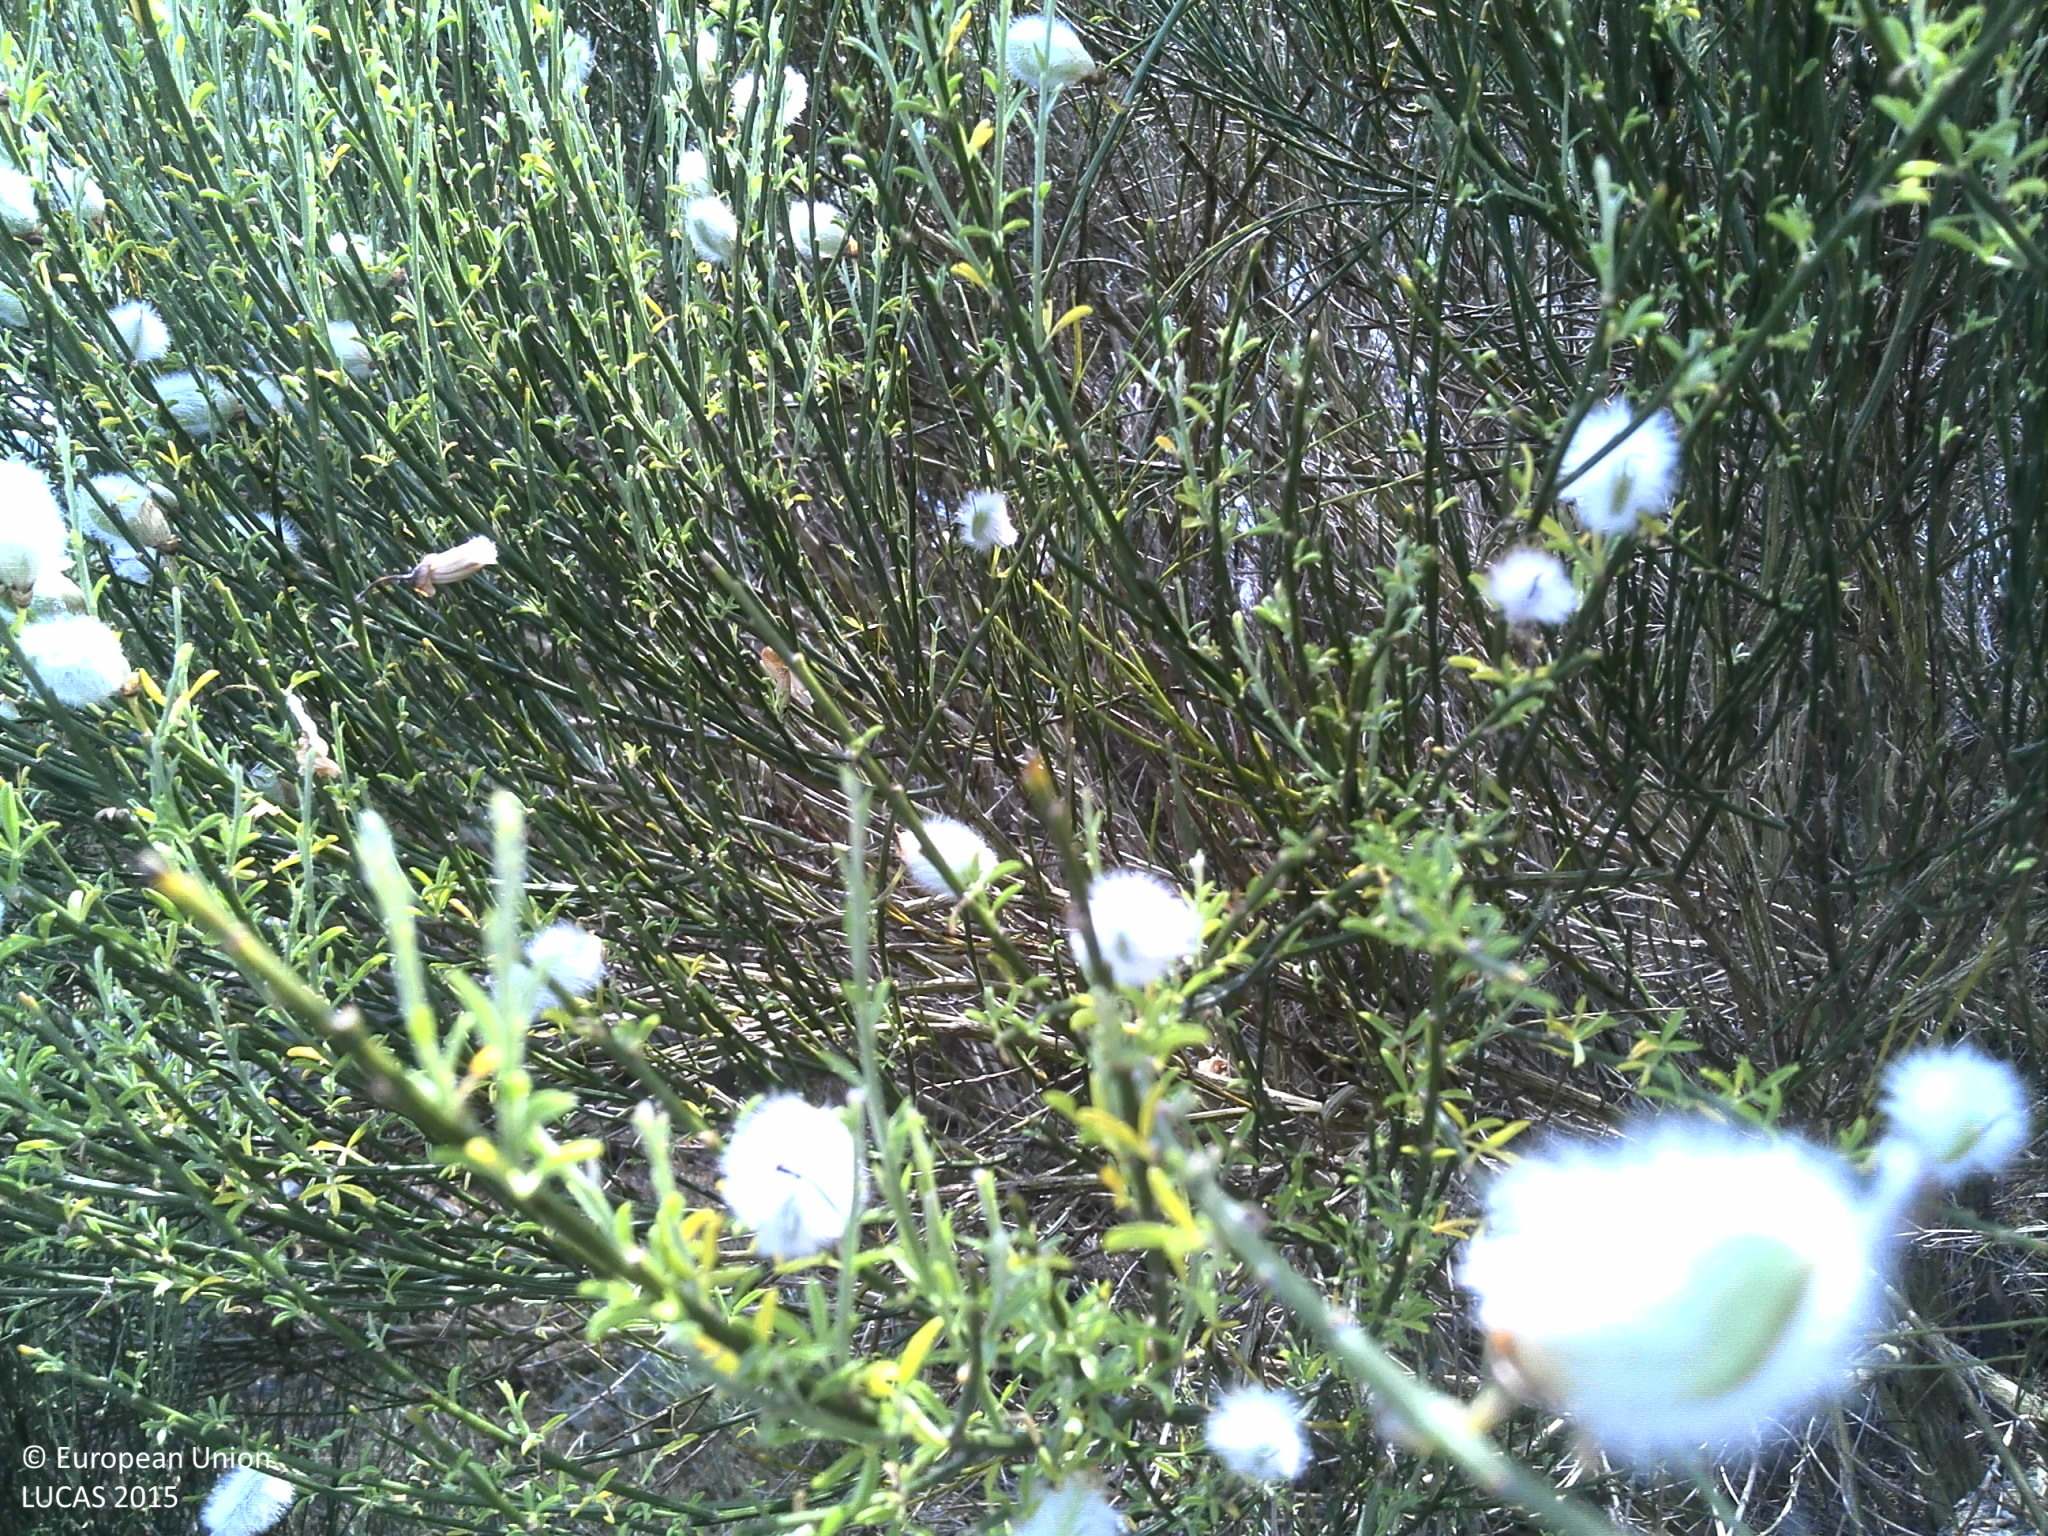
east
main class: Shrubland
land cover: Shrubland without tree cover
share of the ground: > 75 %
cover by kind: shrubs 50 %, consolidated bare surface 45 %, herbaceous plants 5 %
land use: Semi-natural and natural areas not in use
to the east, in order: Shrubland without tree cover; Rock outcrops; Shrubland without tree cover; Shrubland with sparse tree cover; Rocks and stones; Shrubland without tree cover; Rocks and stones; Shrubland without tree cover; Rocks and stones; Shrubland without tree cover; Rocks and stones; Shrubland without tree cover; Rocks and stones
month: June
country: PT
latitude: 41.3975
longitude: -7.5782
